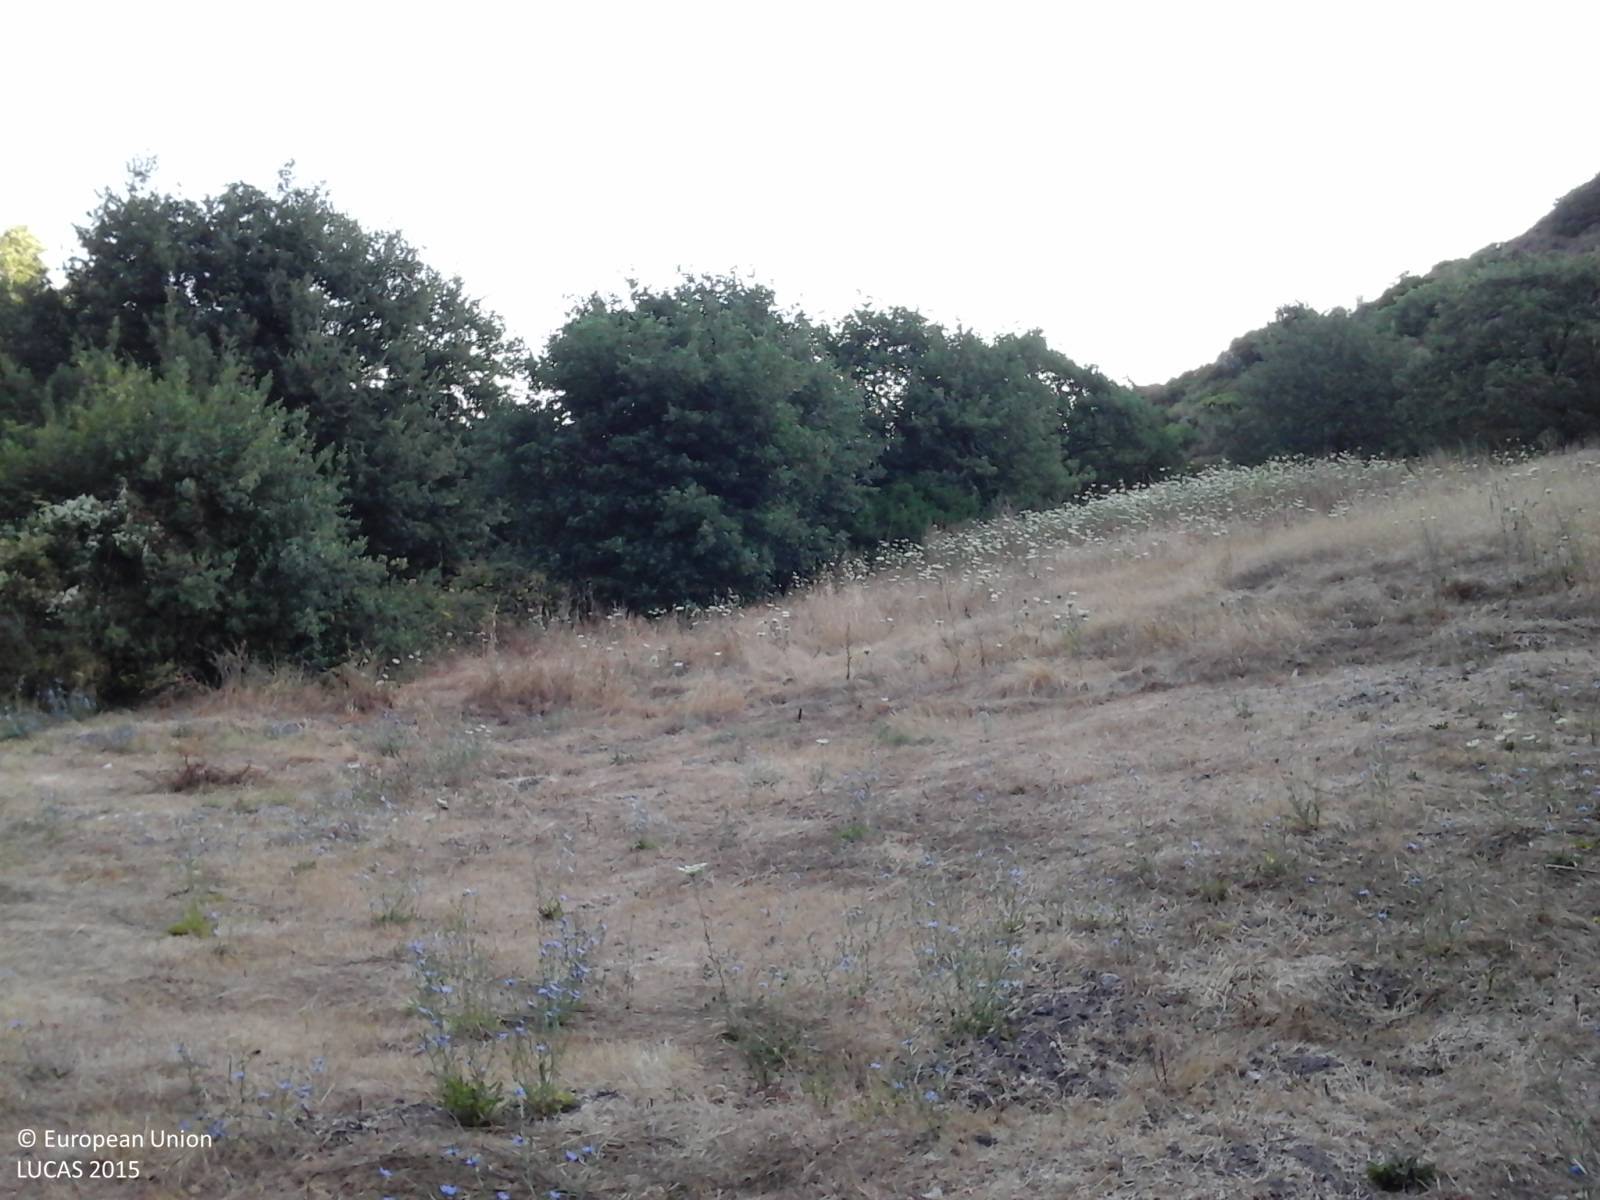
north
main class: Grassland
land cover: Grassland without tree/shrub cover
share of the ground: 25 - 50 %
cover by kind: herbaceous plants 100 %
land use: Agriculture (excluding fallow land and kitchen gardens)
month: July
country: IT
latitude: 40.7488
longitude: 8.8095
